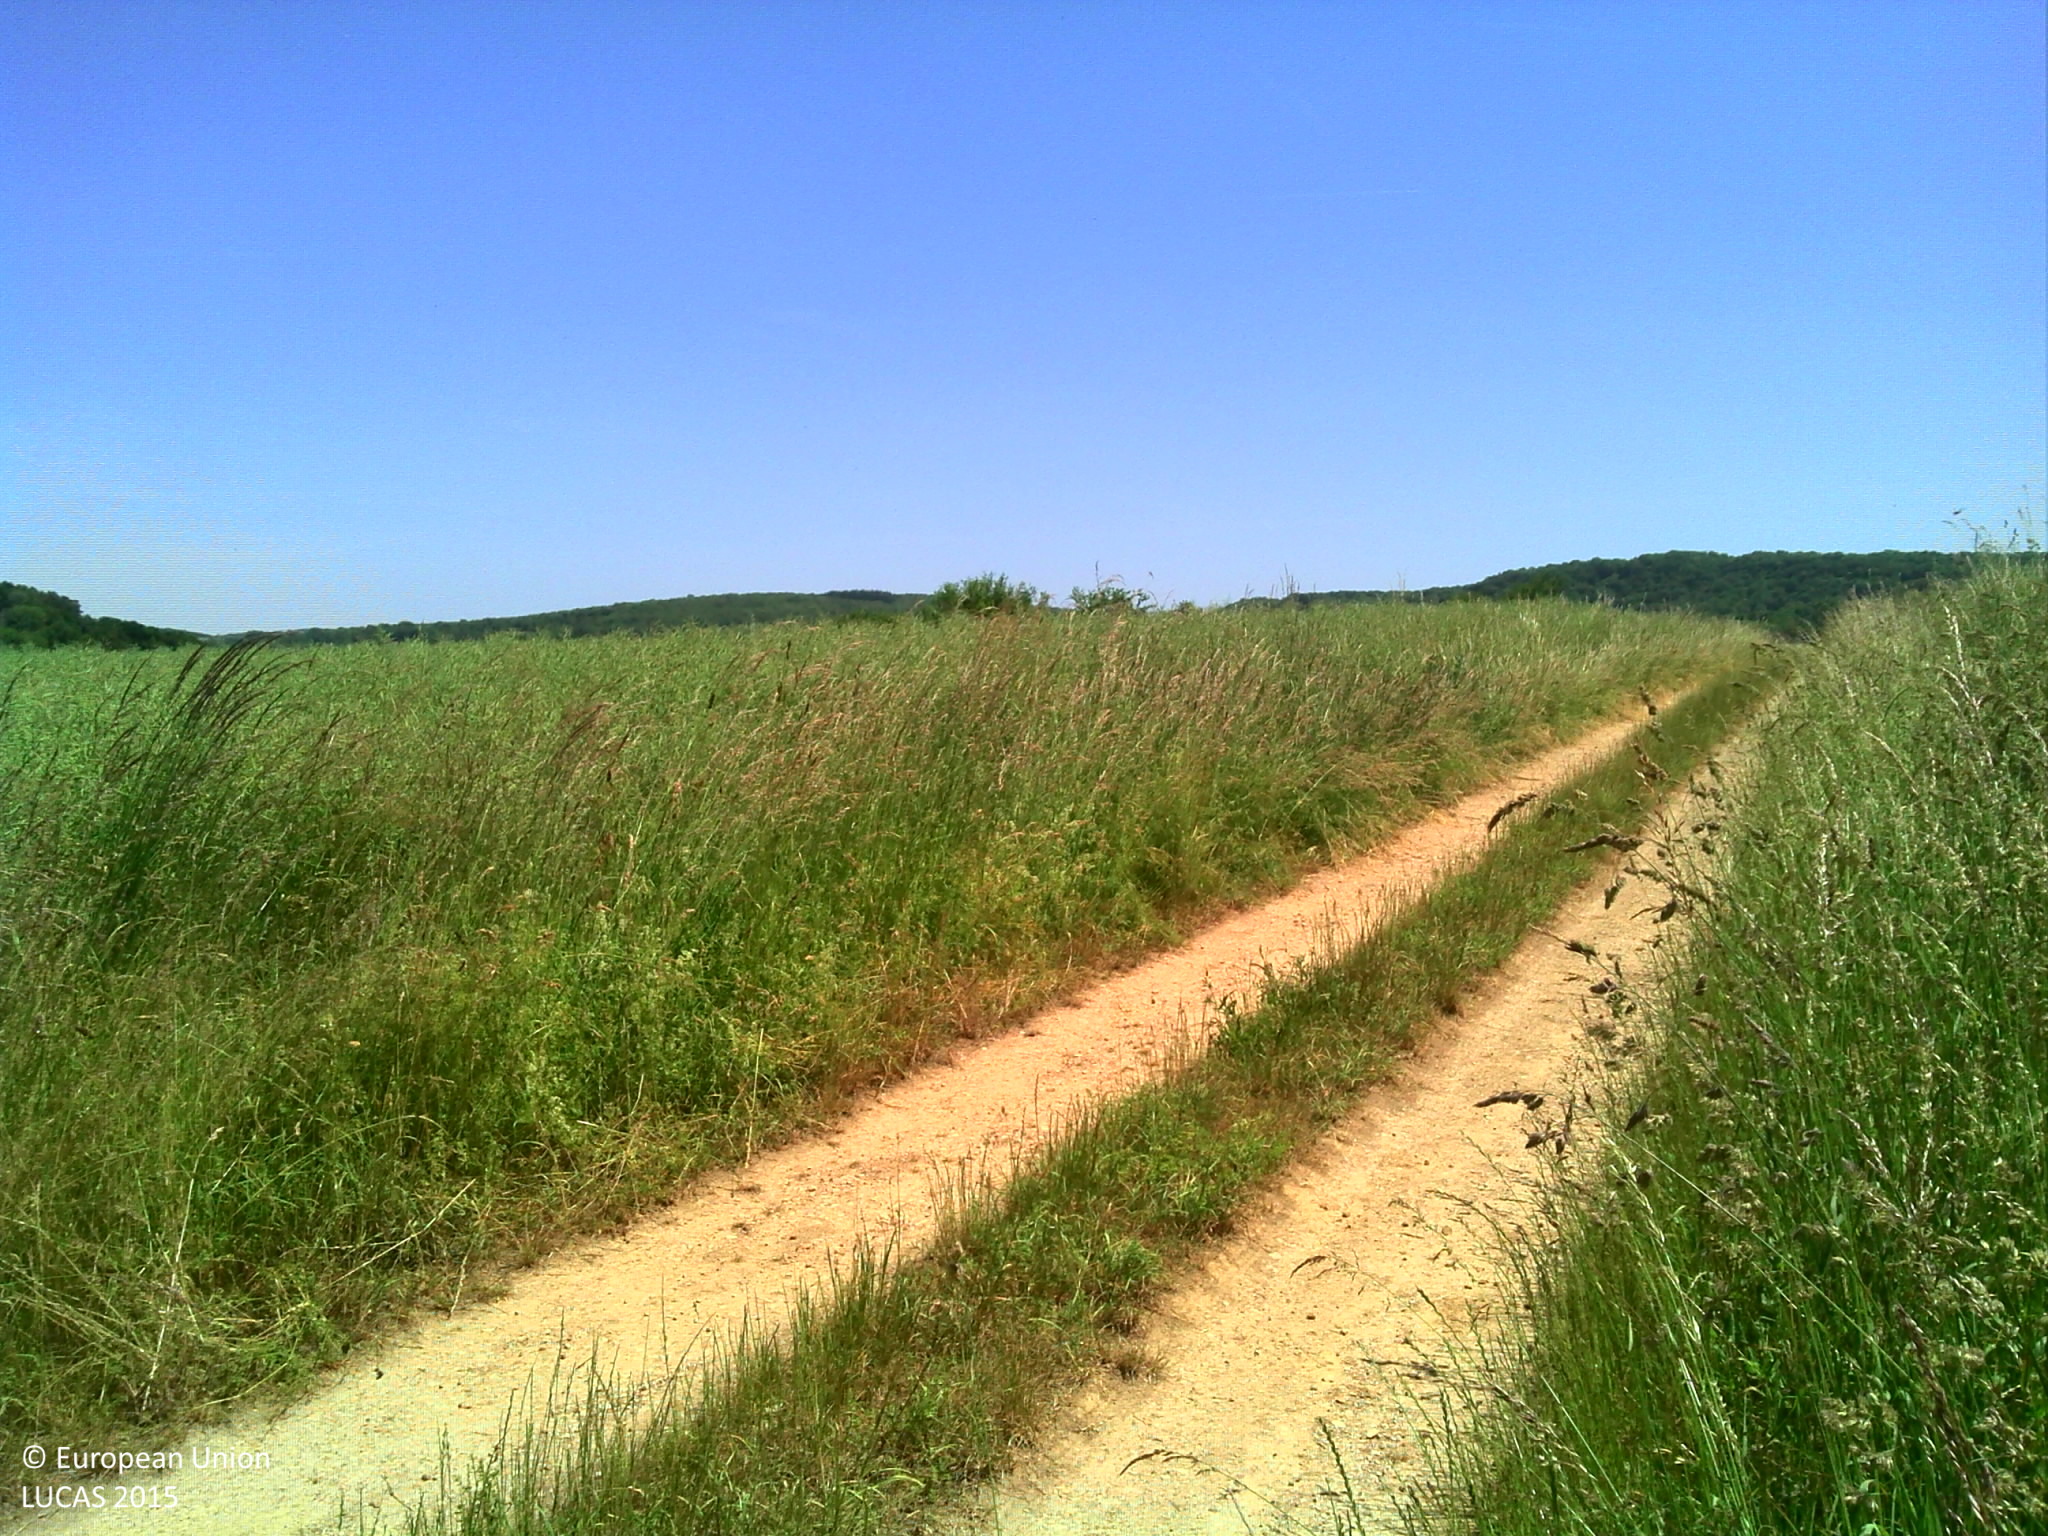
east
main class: Cropland
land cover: Rape and turnip rape
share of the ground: > 75 %
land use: Agriculture (excluding fallow land and kitchen gardens)
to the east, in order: Rape and turnip rape; Grass margins; Tracks; Grass margins; Rape and turnip rape; Lines of trees; Rape and turnip rape
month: June
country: FR
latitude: 47.5394
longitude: 6.0290
